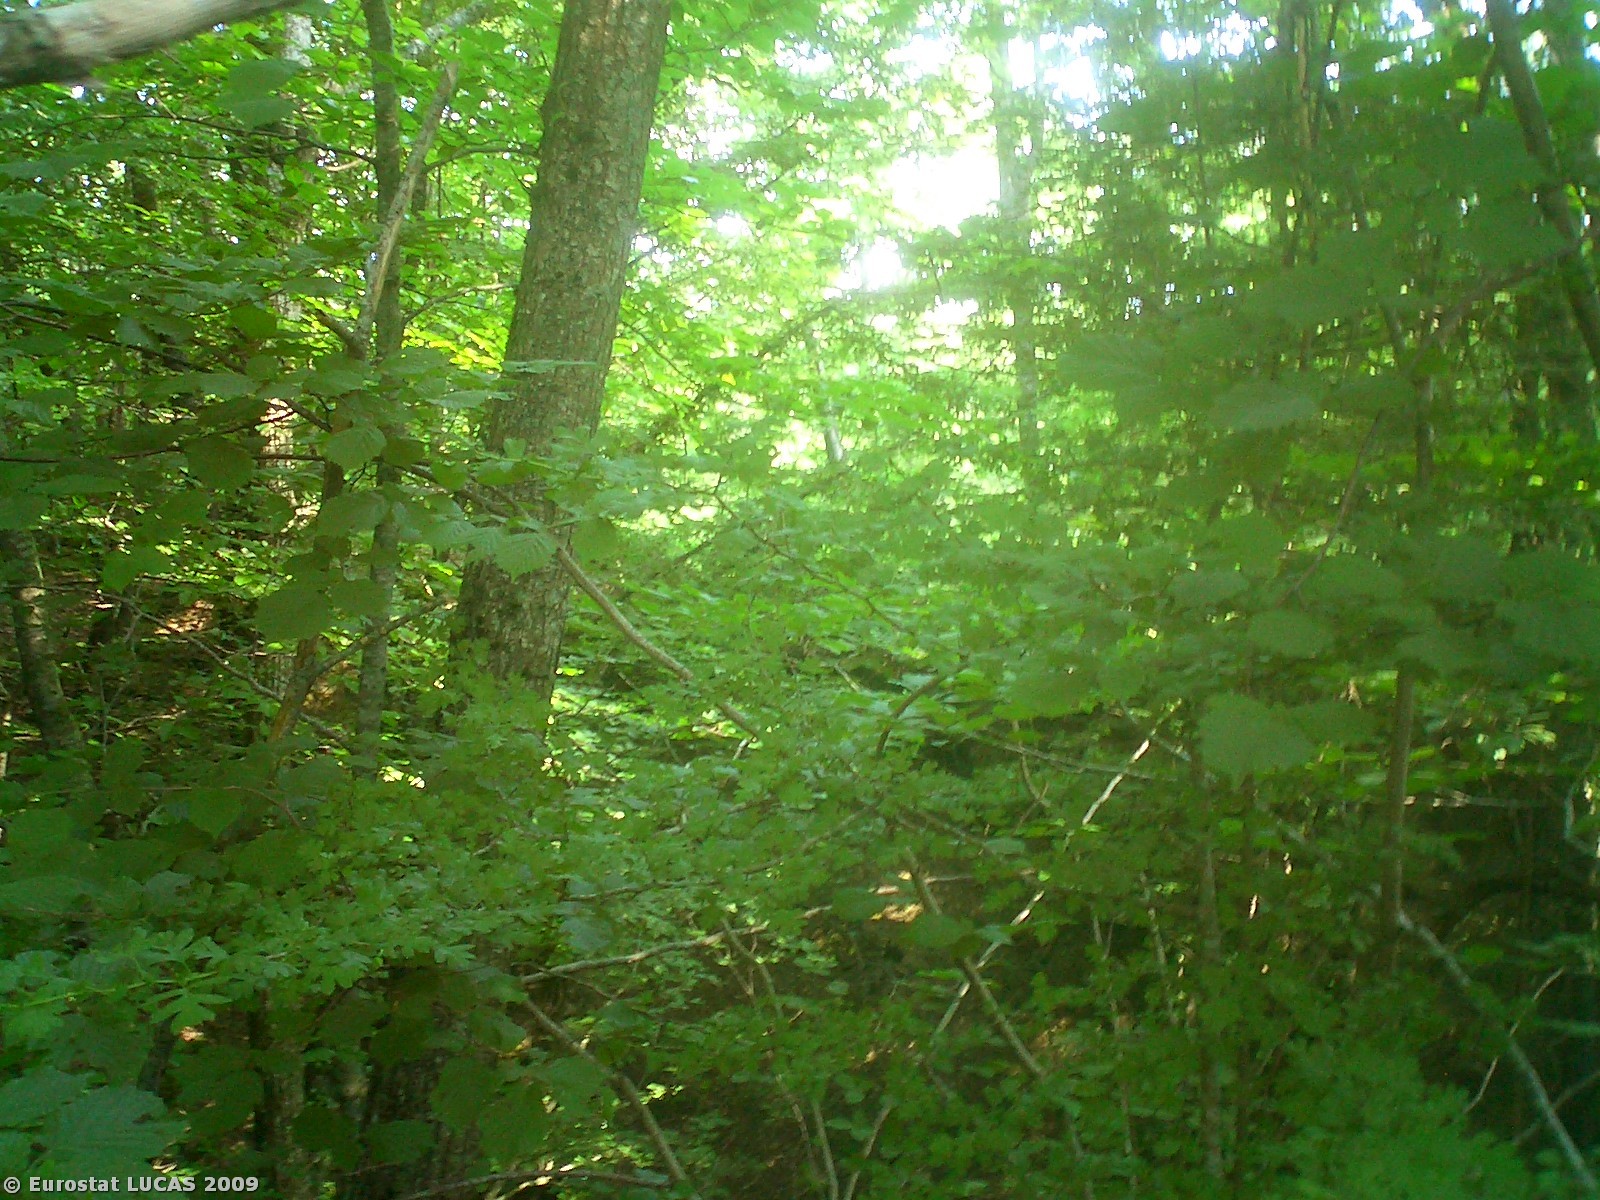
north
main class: Woodland
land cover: Broadleaved woodland
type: mesophytic deciduous forest
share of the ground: > 75 %
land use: Forestry
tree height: > 5 m
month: June
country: IT
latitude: 43.7715
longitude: 12.0199
